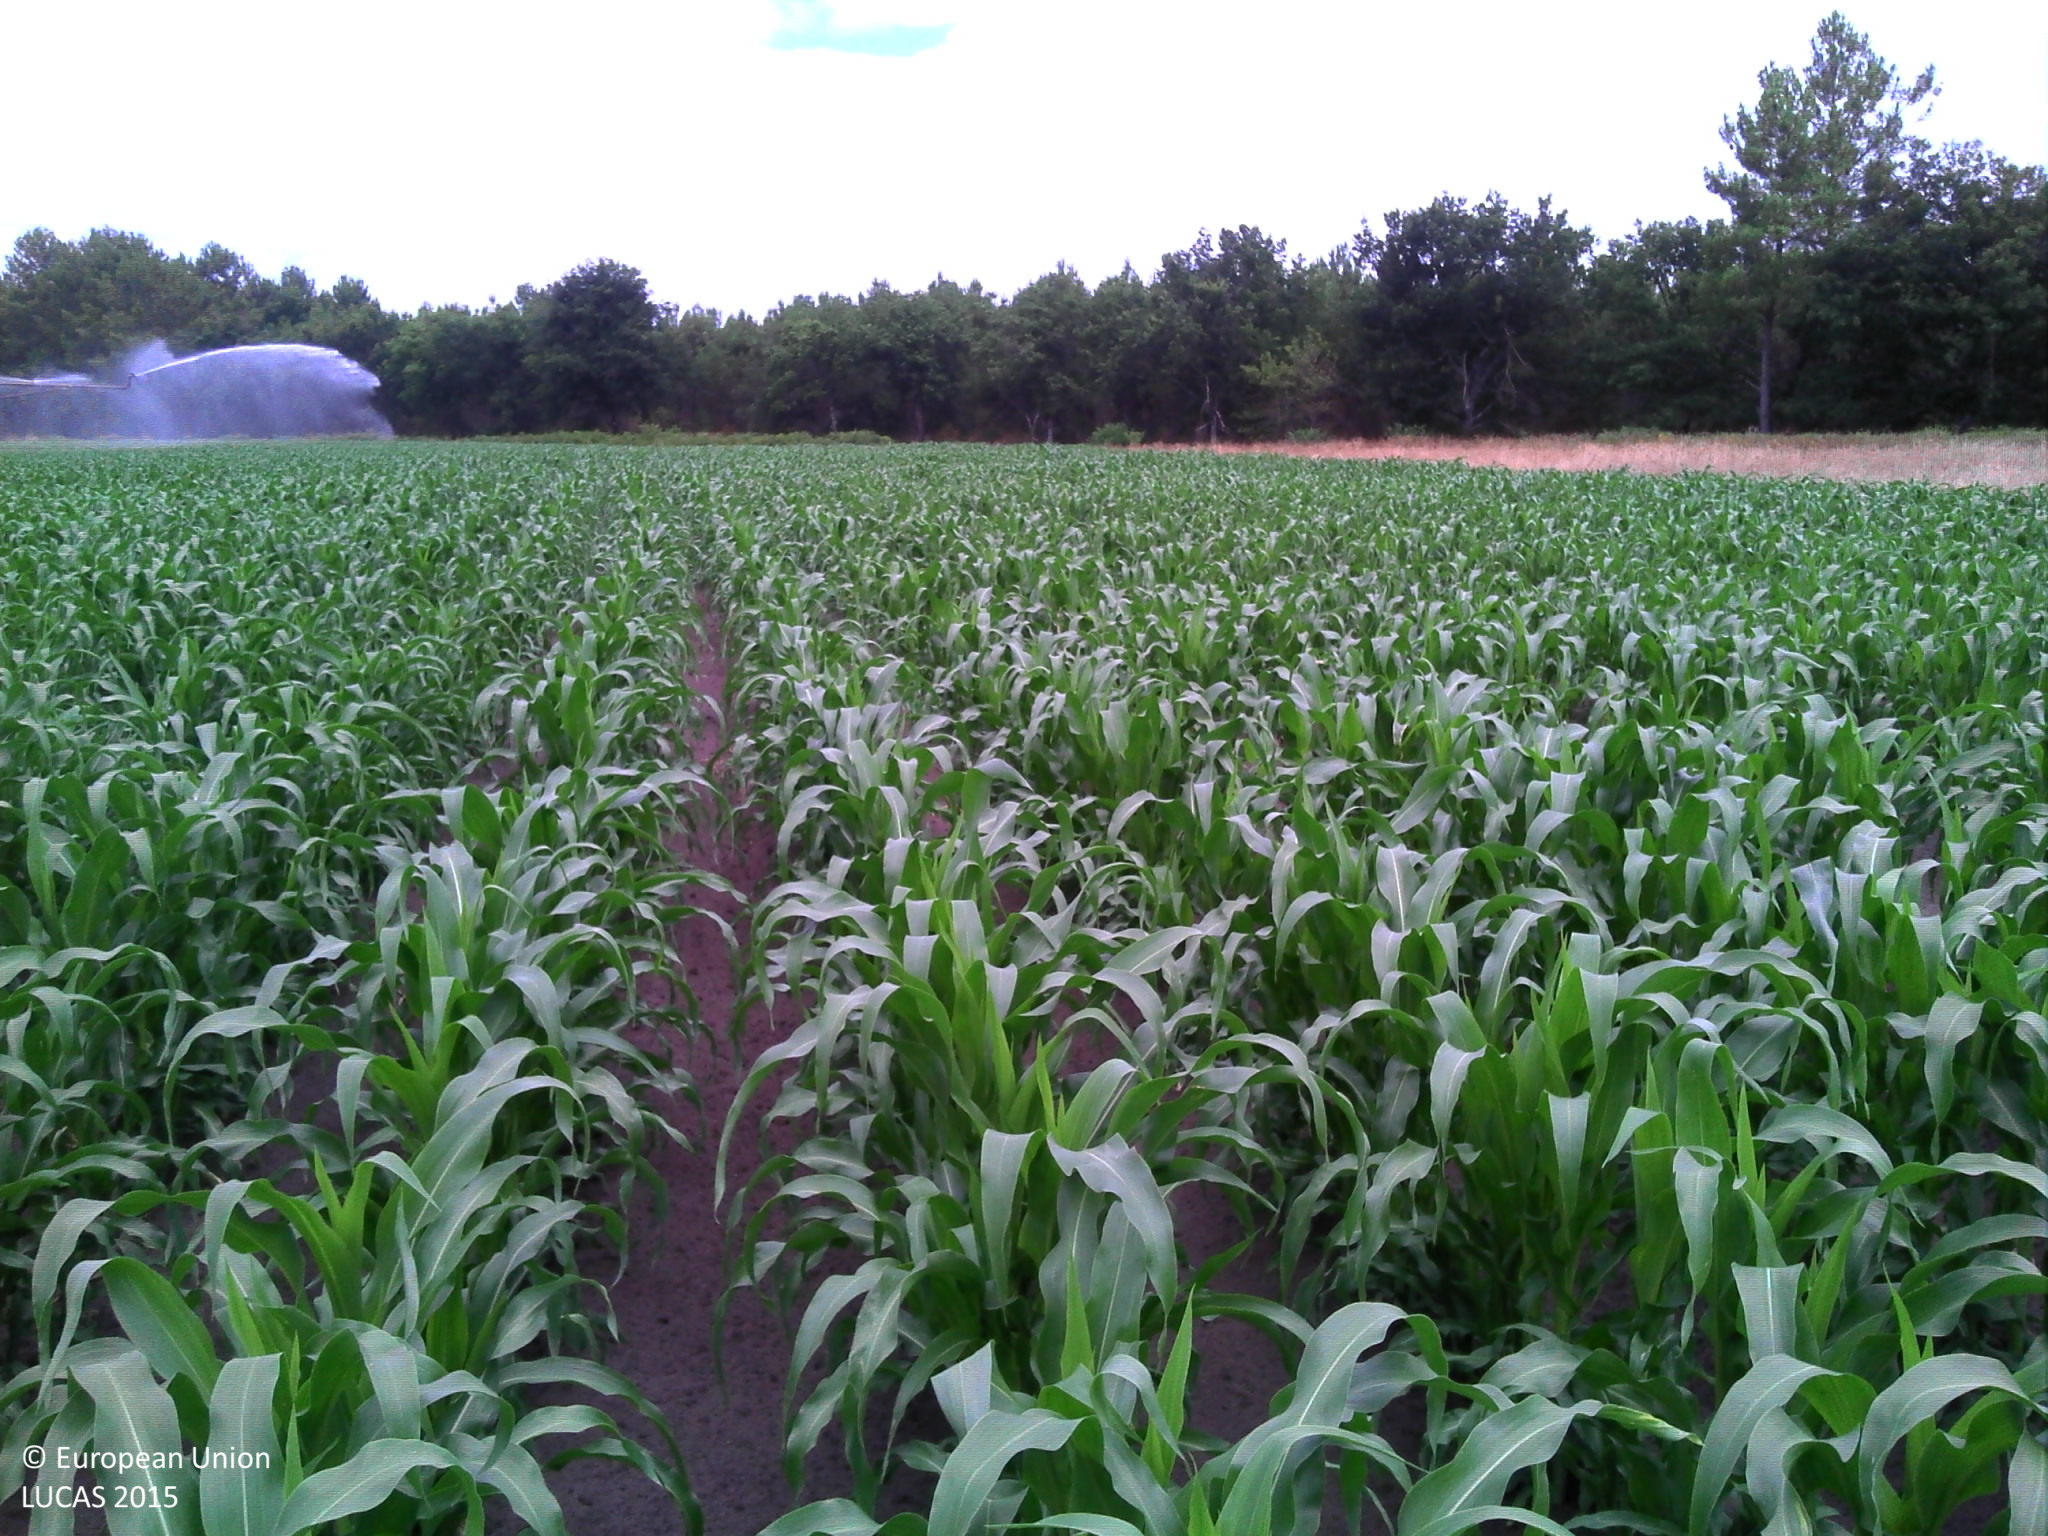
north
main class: Cropland
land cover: Maize
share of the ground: > 75 %
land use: Agriculture (excluding fallow land and kitchen gardens)
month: July
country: FR
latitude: 44.1048
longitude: -0.8730
